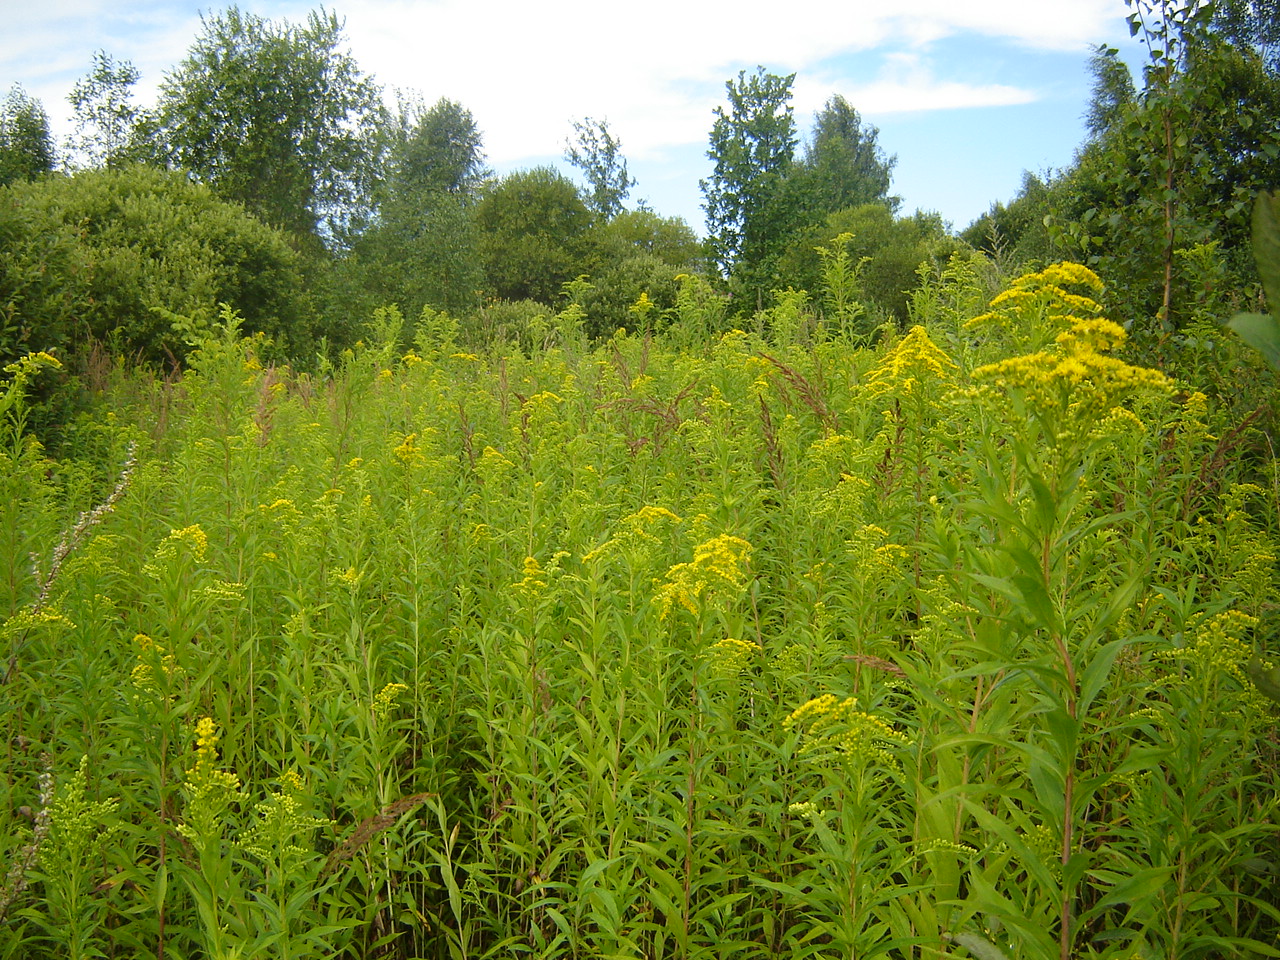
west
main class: Woodland
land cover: Broadleaved woodland
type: non-riverine alder, birch or aspen forest
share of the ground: > 75 %
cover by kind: broadleaved forest trees 90 %, coniferous forest trees 10 %
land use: Forestry
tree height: < 5 m
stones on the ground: < 10 %
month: August
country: LT
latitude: 54.9625
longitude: 24.9018
